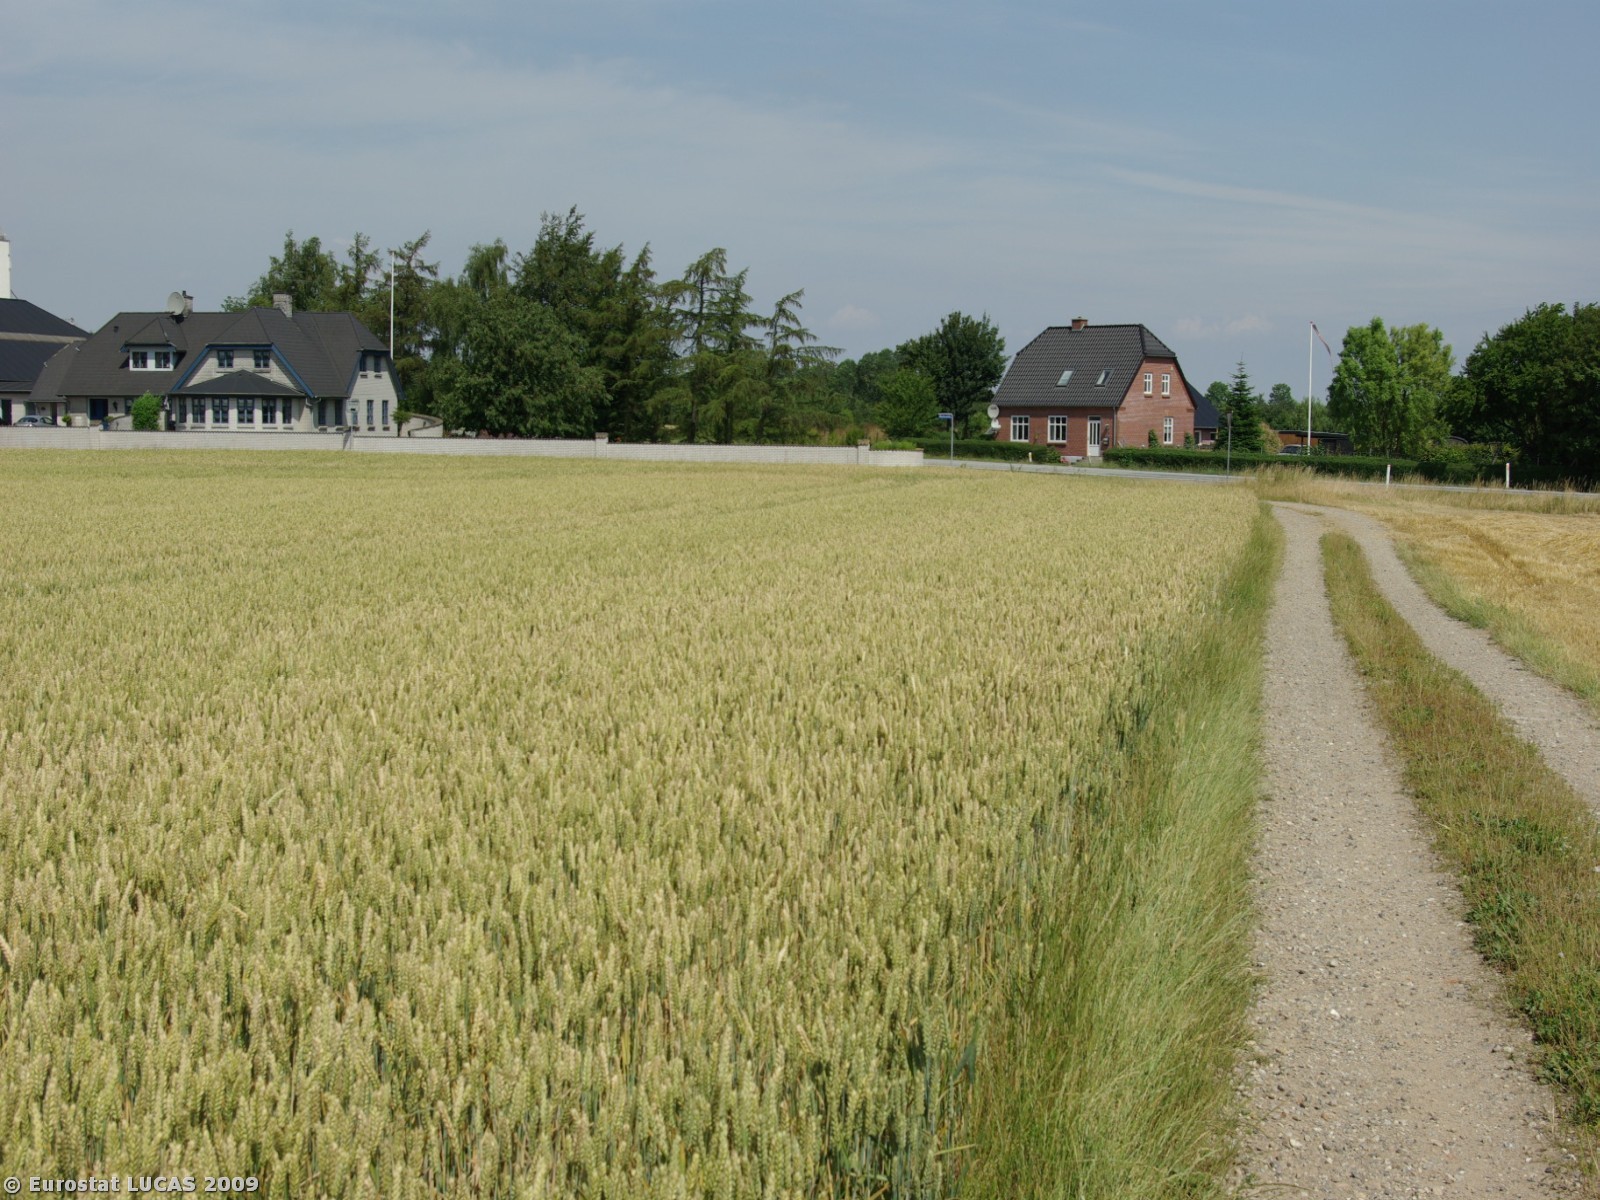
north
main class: Cropland
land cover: Common wheat
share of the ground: > 75 %
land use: Agriculture (excluding fallow land and kitchen gardens)
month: July
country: DK
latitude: 54.9651
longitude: 9.6723
